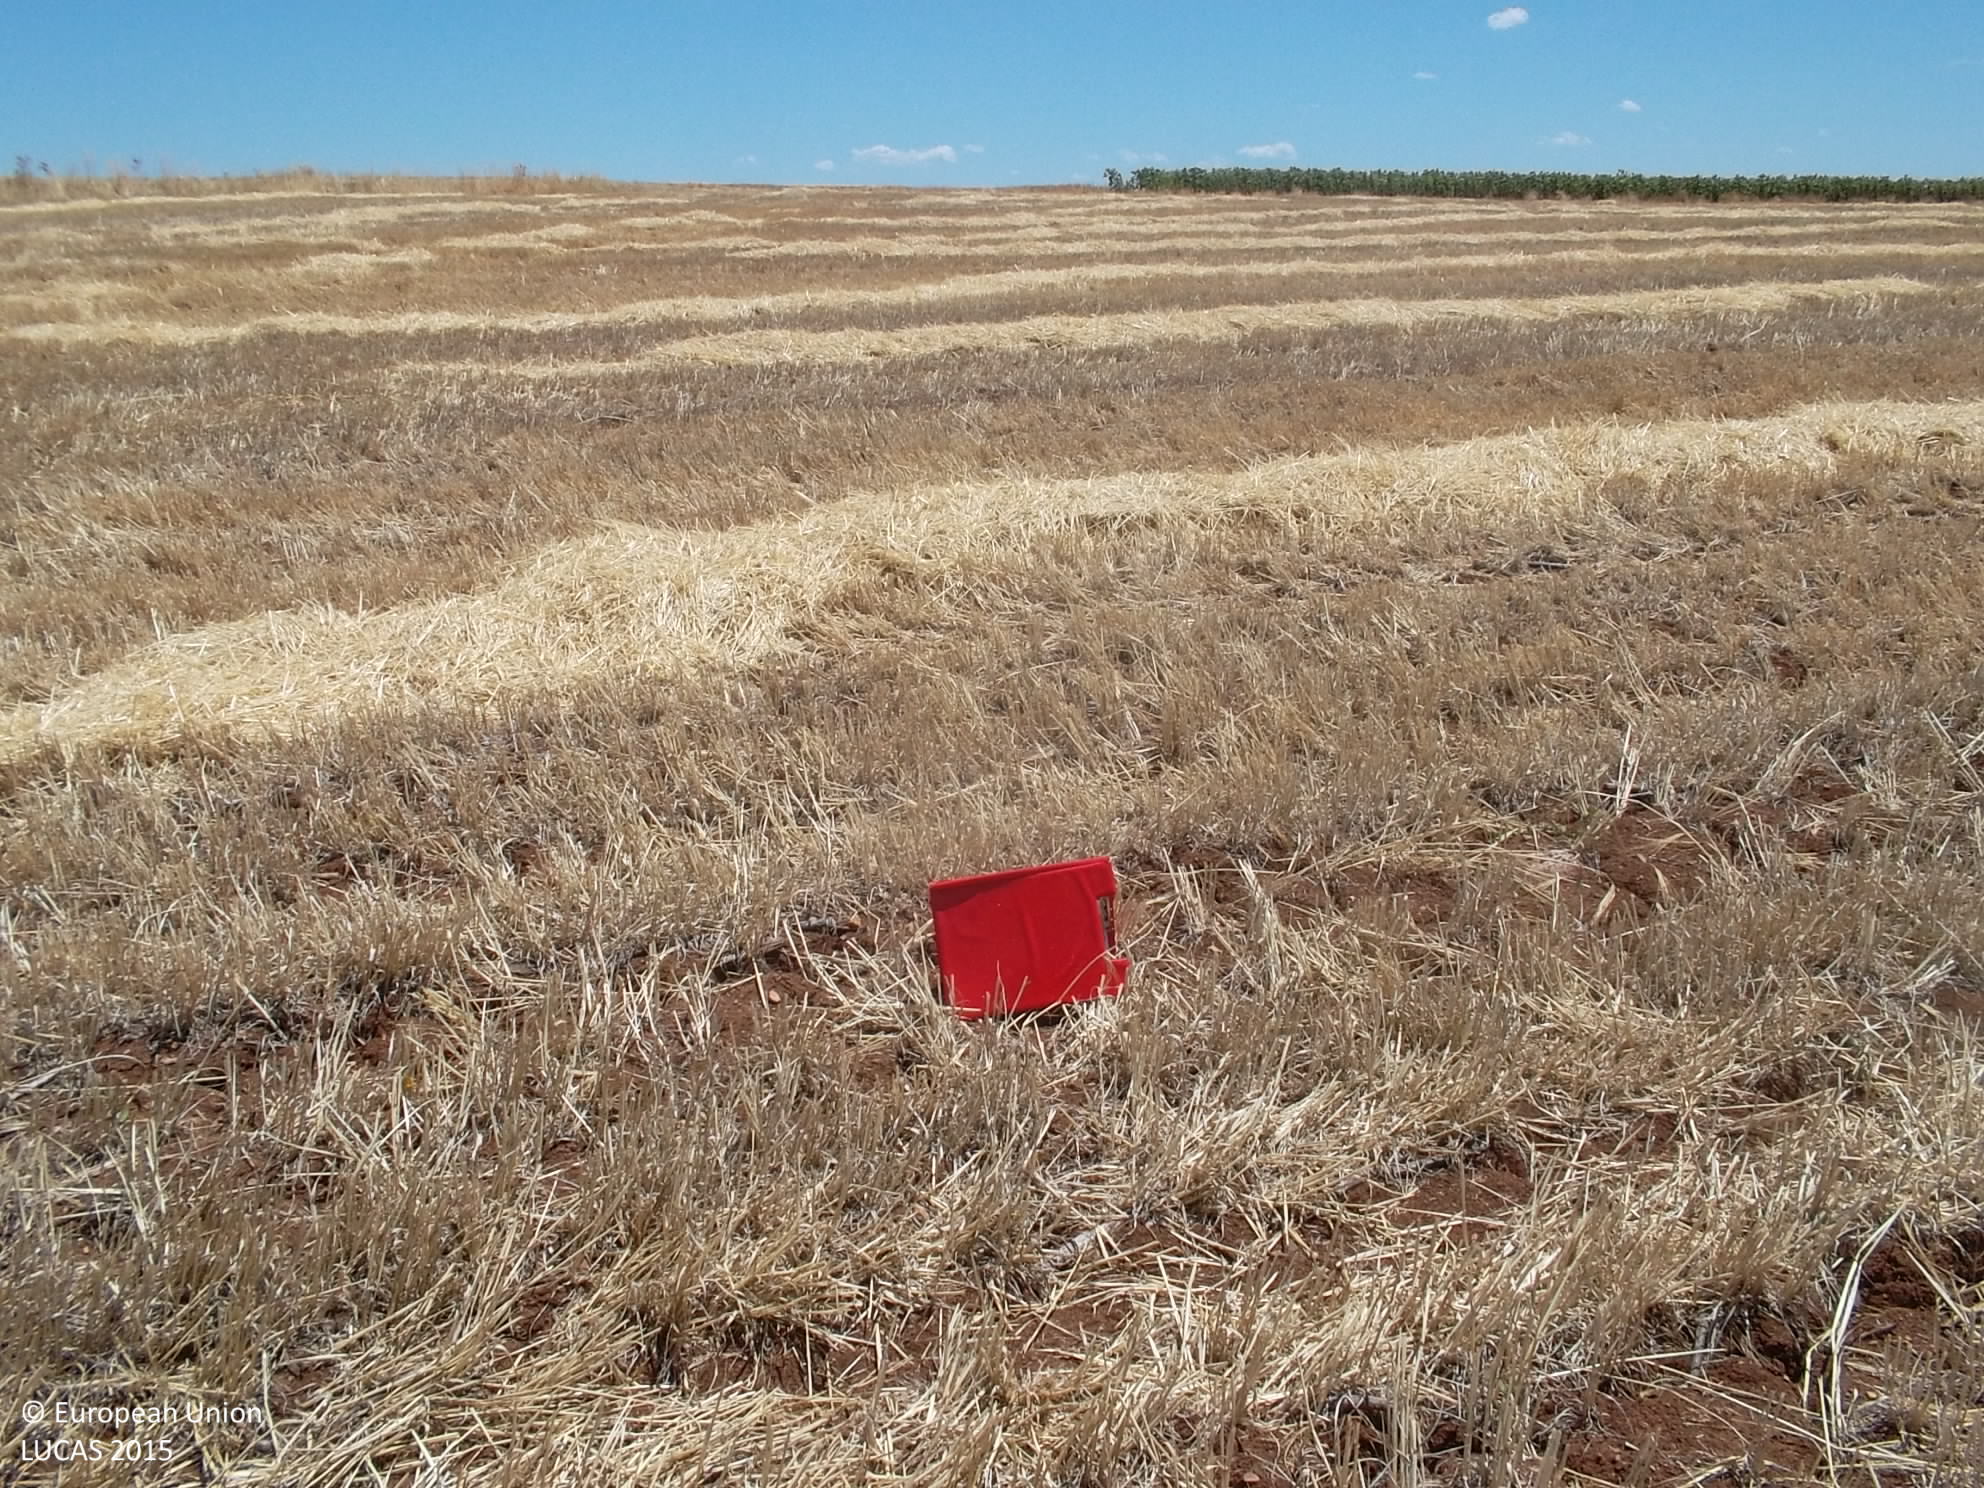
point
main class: Cropland
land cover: Barley
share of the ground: < 10 %
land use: Agriculture (excluding fallow land and kitchen gardens)
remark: Harvested field
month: July
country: ES
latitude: 38.3316
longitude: -5.8132
